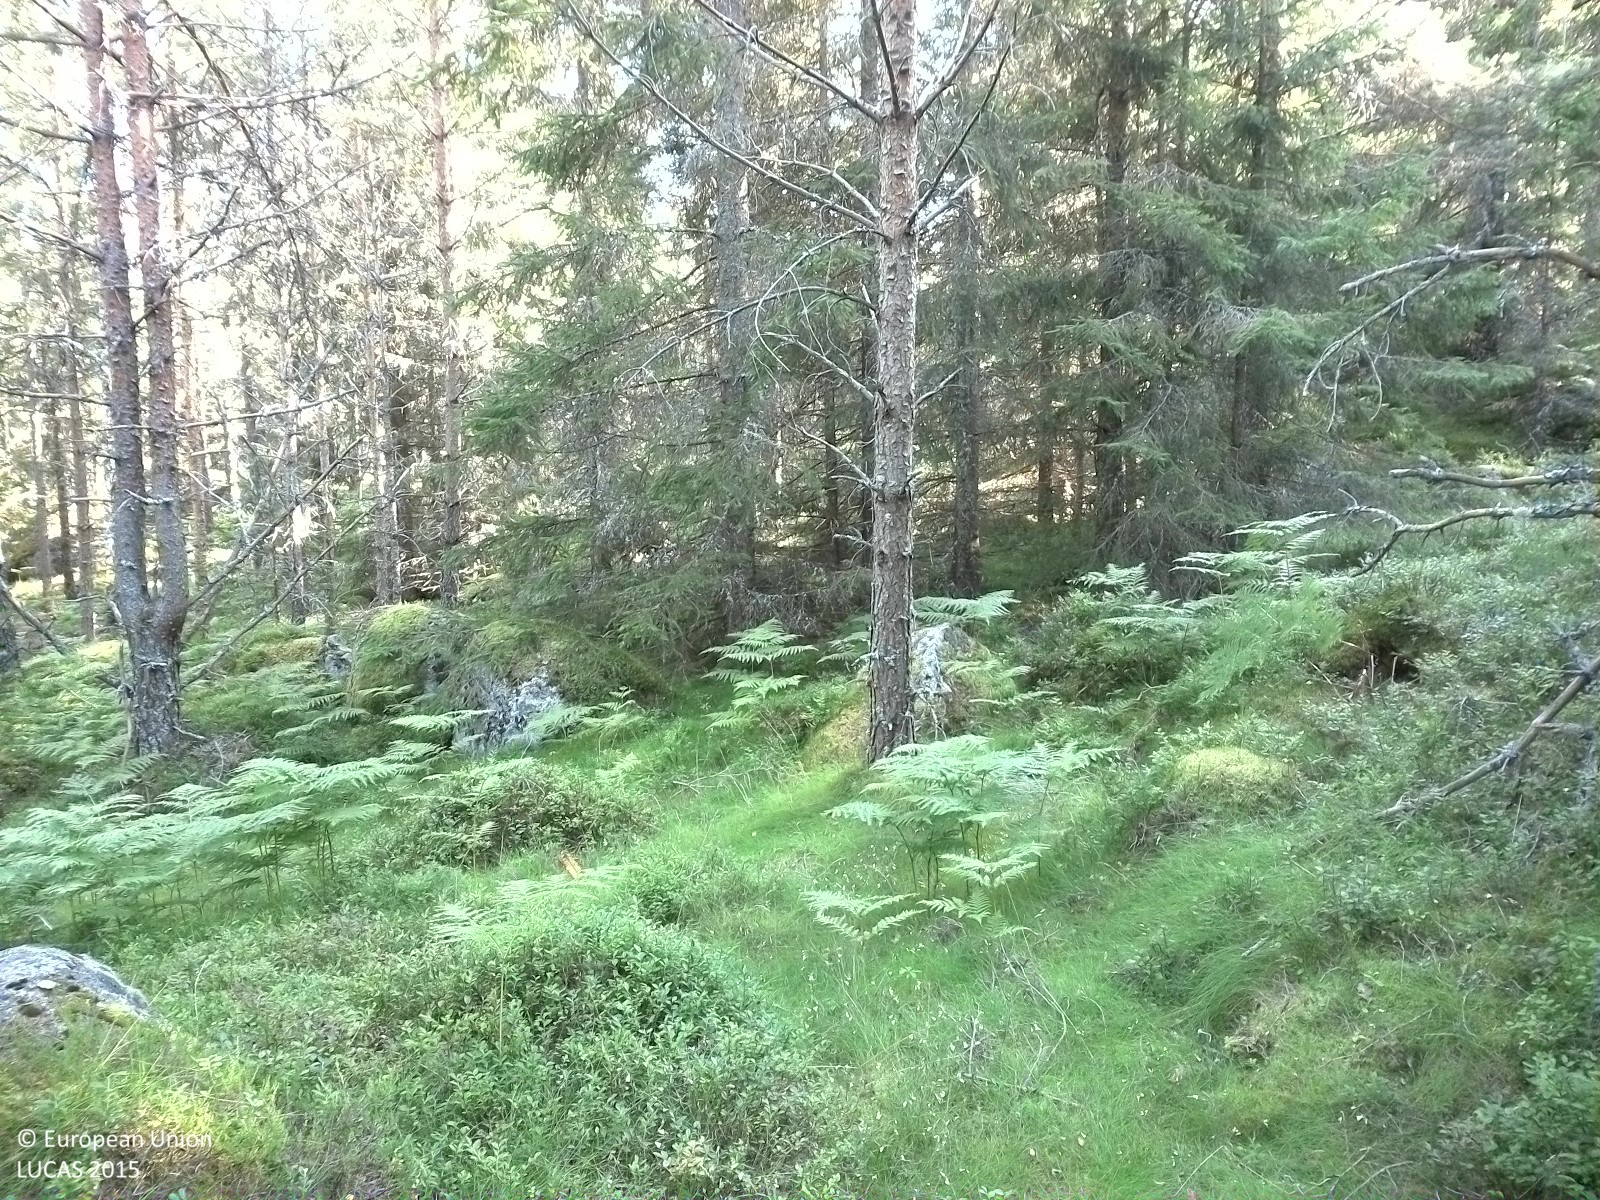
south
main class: Woodland
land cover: Other coniferous woodland
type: boreal forest
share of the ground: 25 - 50 %
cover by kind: herbaceous plants 45 %, coniferous forest trees 40 %, lichens and mosses 15 %
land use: Forestry
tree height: > 5 m
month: August
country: SE
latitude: 59.2199
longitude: 14.6693
